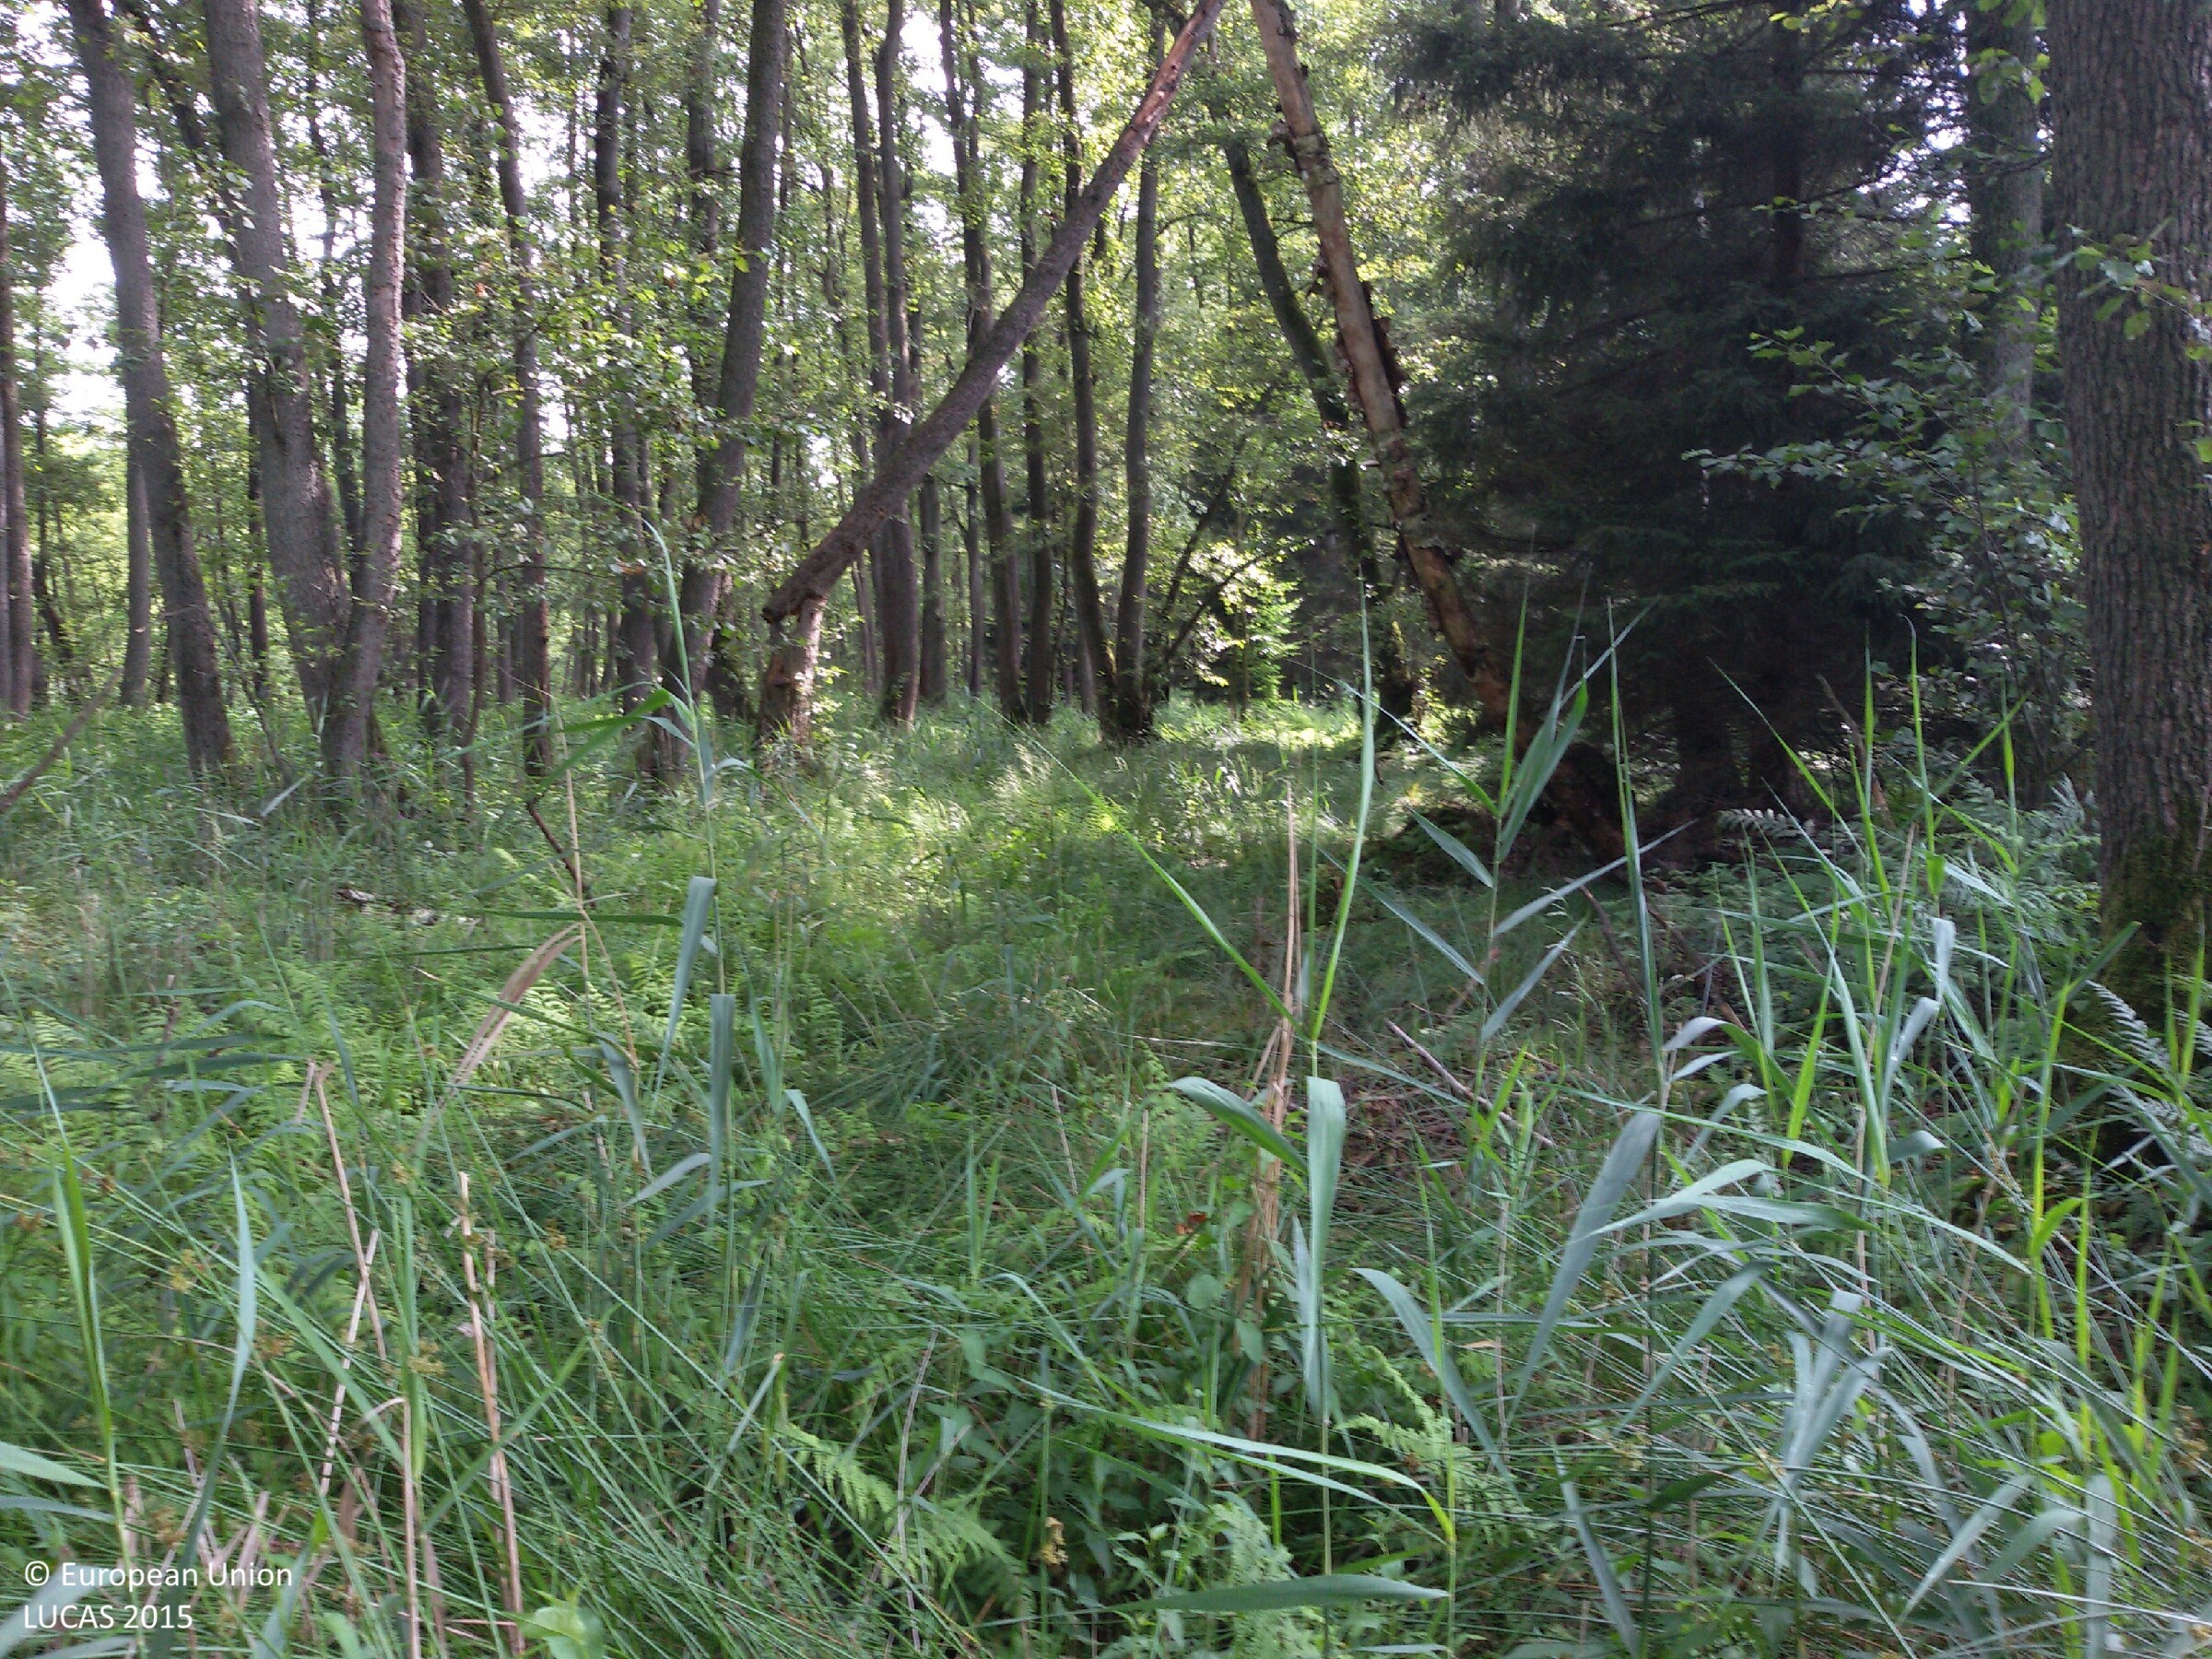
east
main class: Woodland
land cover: Broadleaved woodland
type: non-riverine alder, birch or aspen forest
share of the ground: > 75 %
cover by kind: broadleaved forest trees 90 %, herbaceous plants 10 %
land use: Forestry
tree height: > 5 m
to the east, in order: Broadleaved woodland; Fences; Pine dominated mixed woodland; Fences; Pine dominated coniferous woodland; Broadleaved woodland
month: July
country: PL
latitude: 53.0865
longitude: 15.7226
